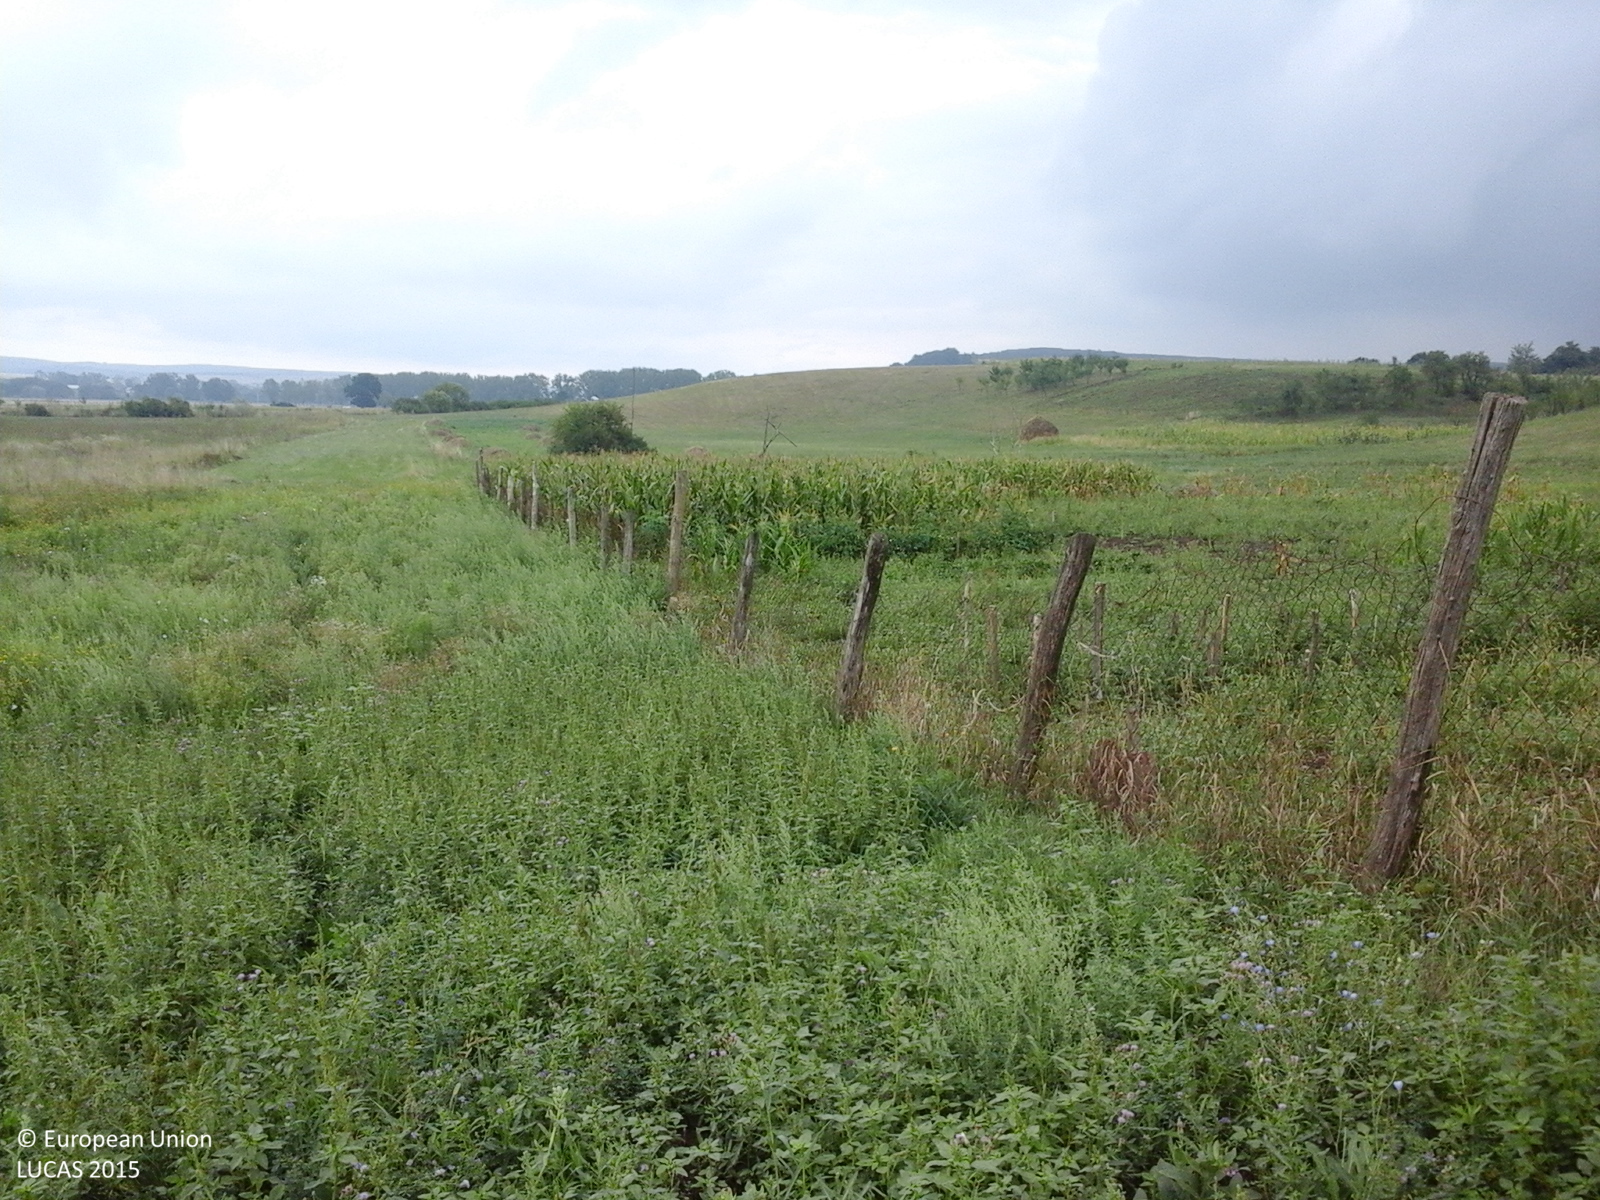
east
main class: Cropland
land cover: Lucerne
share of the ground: > 75 %
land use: Agriculture (excluding fallow land and kitchen gardens)
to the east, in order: Lucerne; Fences; Other fresh vegetables; Spontaneously vegetated surfaces; Maize; Grassland without tree/shrub cover; Spontaneously vegetated surfaces; Maize; Spontaneously vegetated surfaces; Lucerne
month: August
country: RO
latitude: 45.9672
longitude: 21.4813
